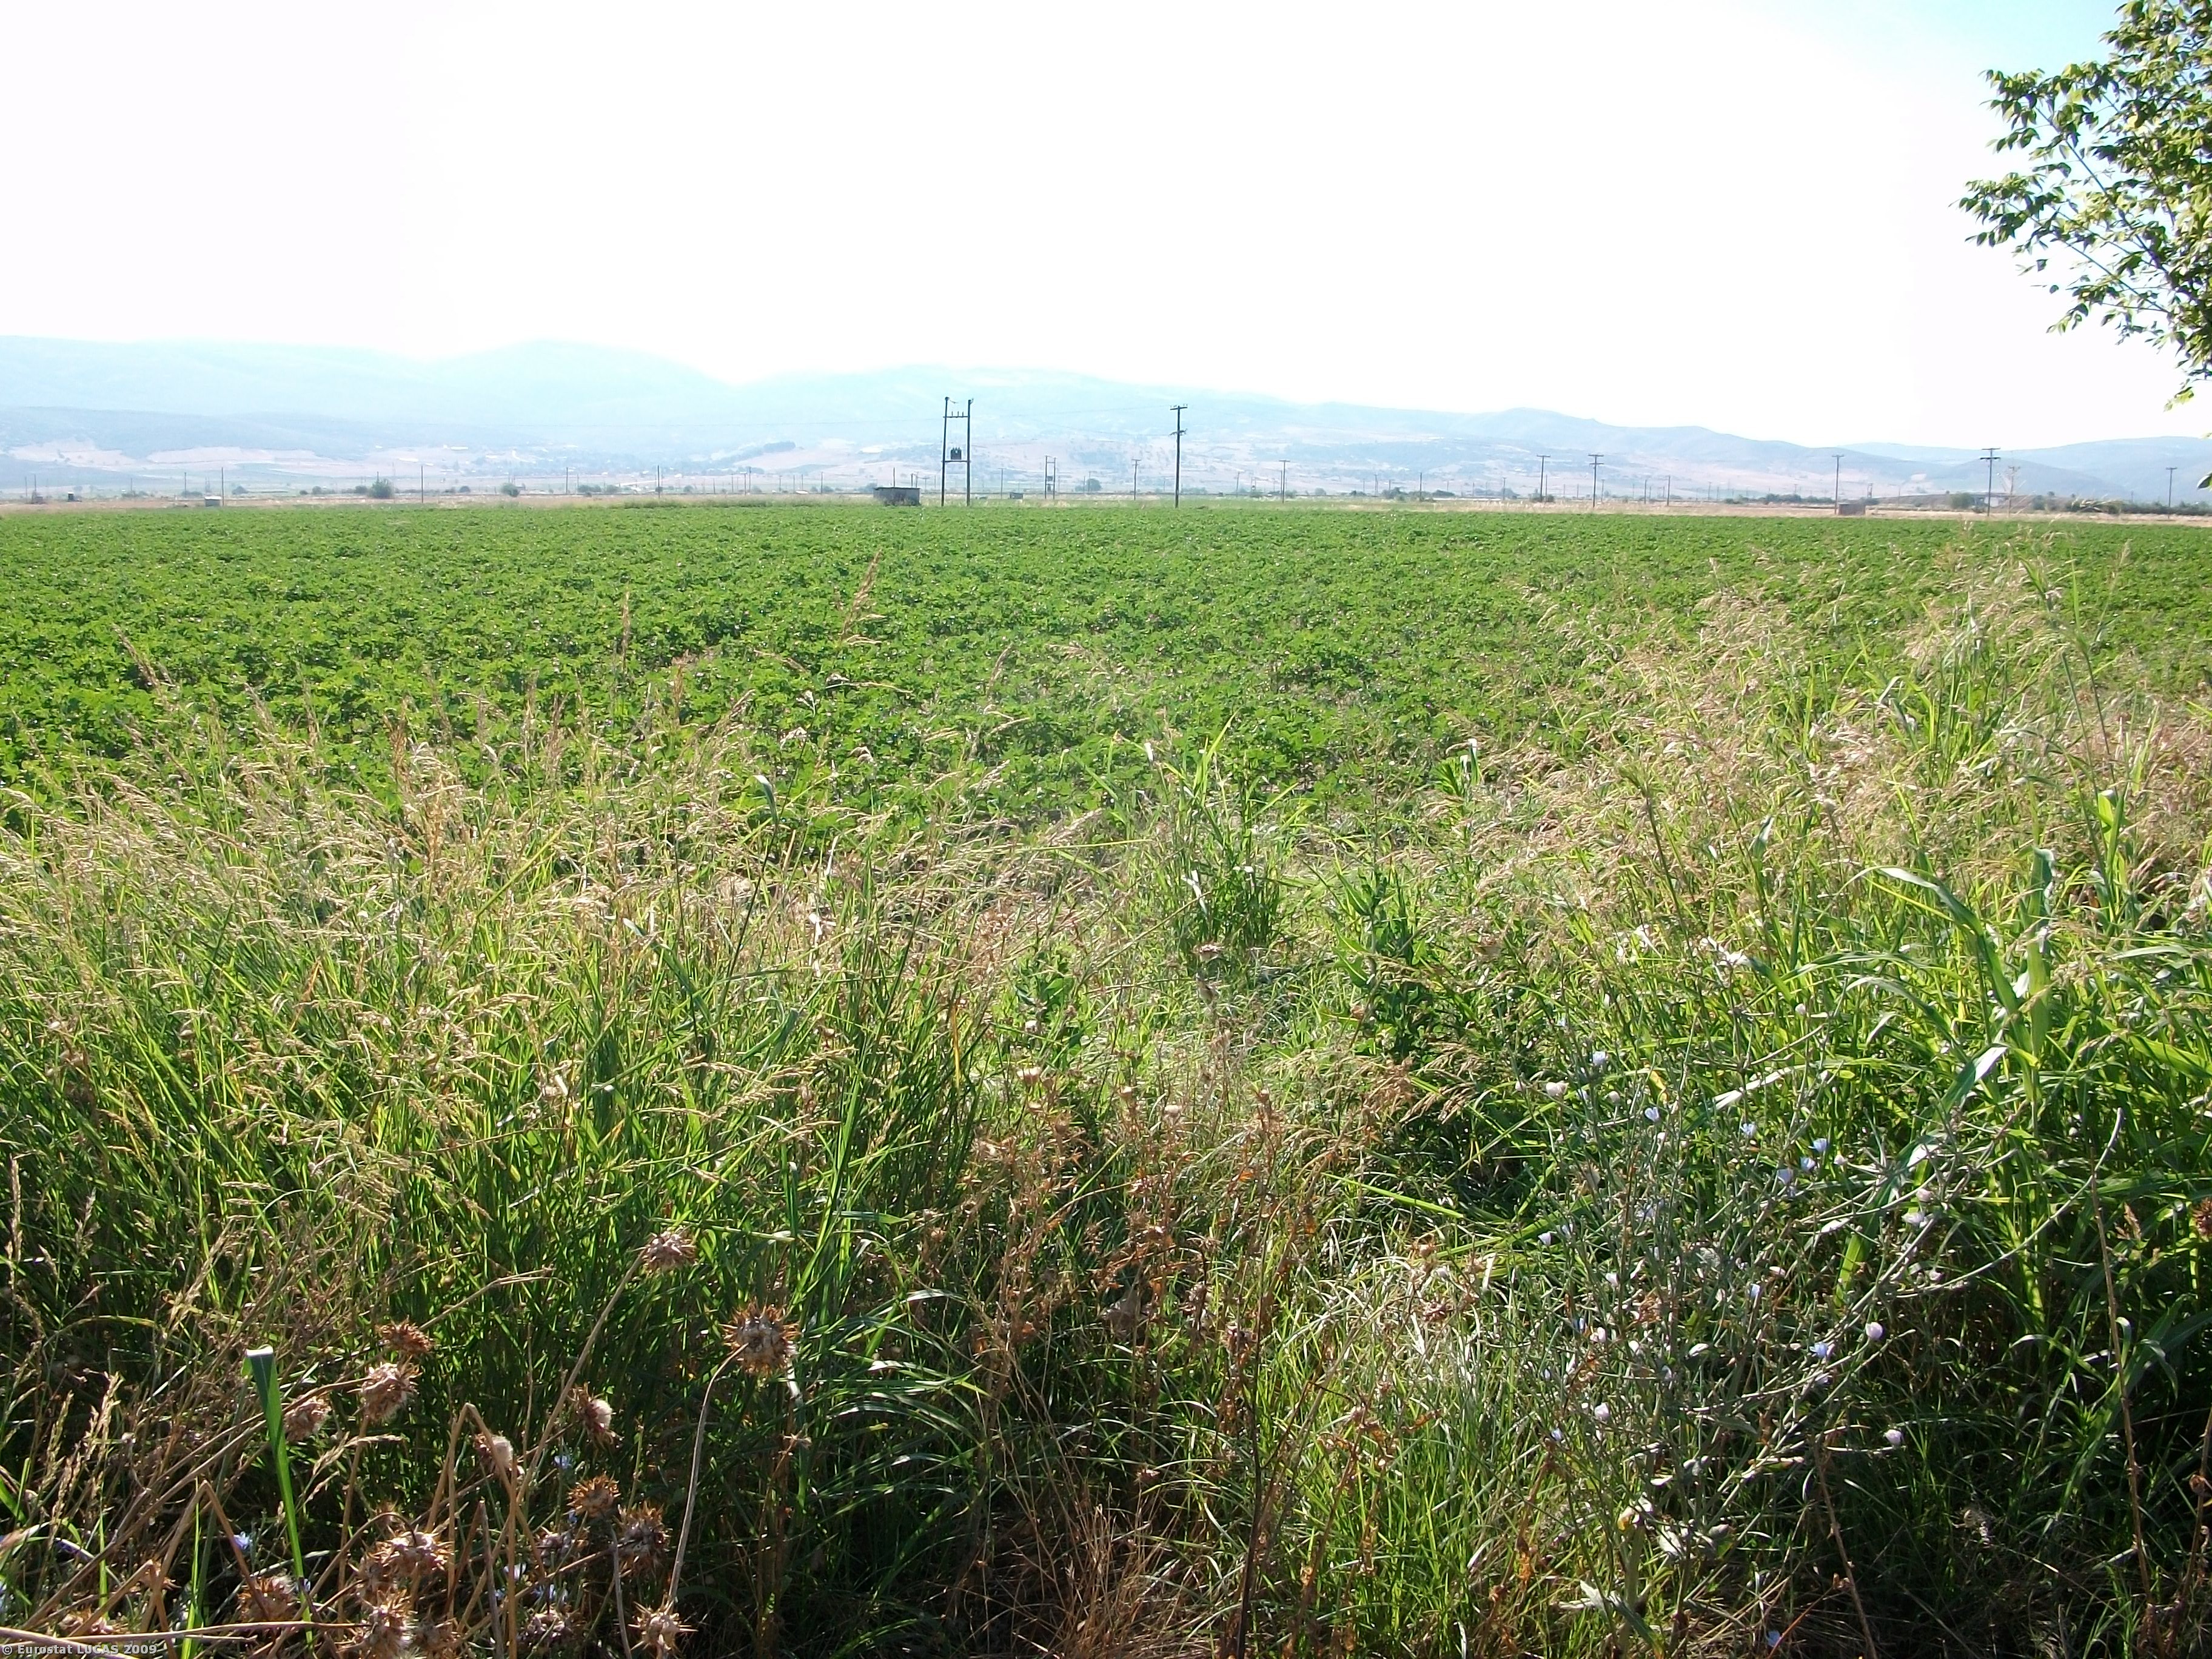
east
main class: Grassland
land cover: Grassland with sparse tree/shrub cover
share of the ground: > 75 %
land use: Unused
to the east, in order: Grassland with sparse tree/shrub cover; Cotton; Electric lines; Grass margins; Cotton
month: July
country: GR
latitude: 39.2016
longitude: 22.2691
